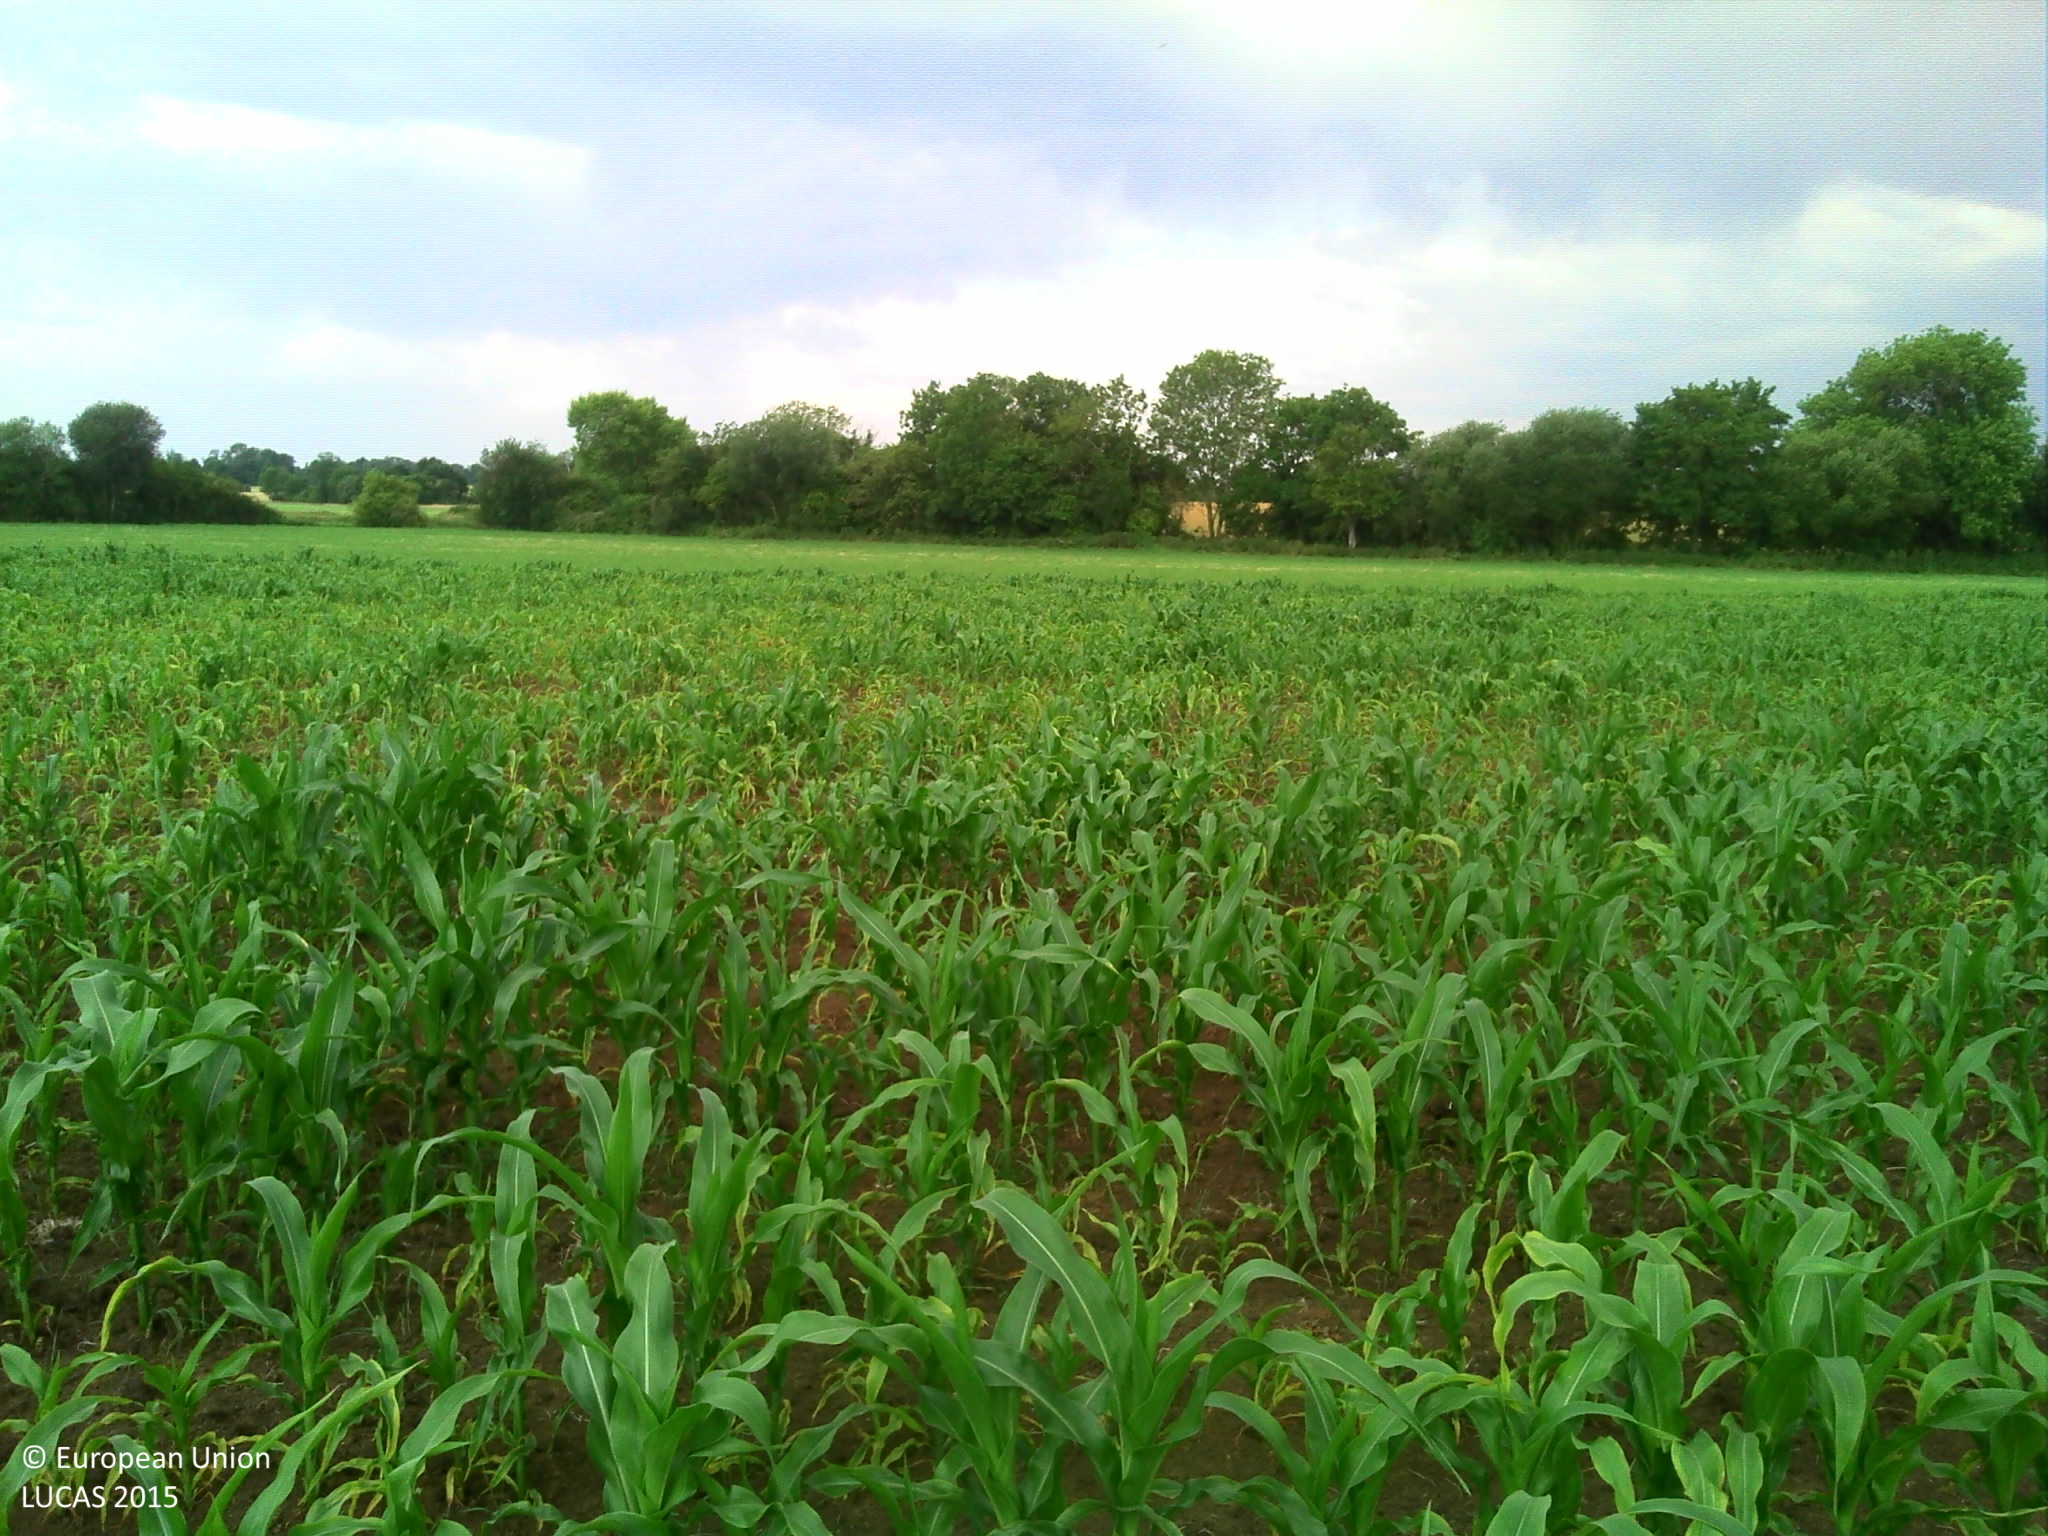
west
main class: Cropland
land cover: Maize
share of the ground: 25 - 50 %
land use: Agriculture (excluding fallow land and kitchen gardens)
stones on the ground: < 10 %
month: July
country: FR
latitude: 48.9297
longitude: 0.0191
